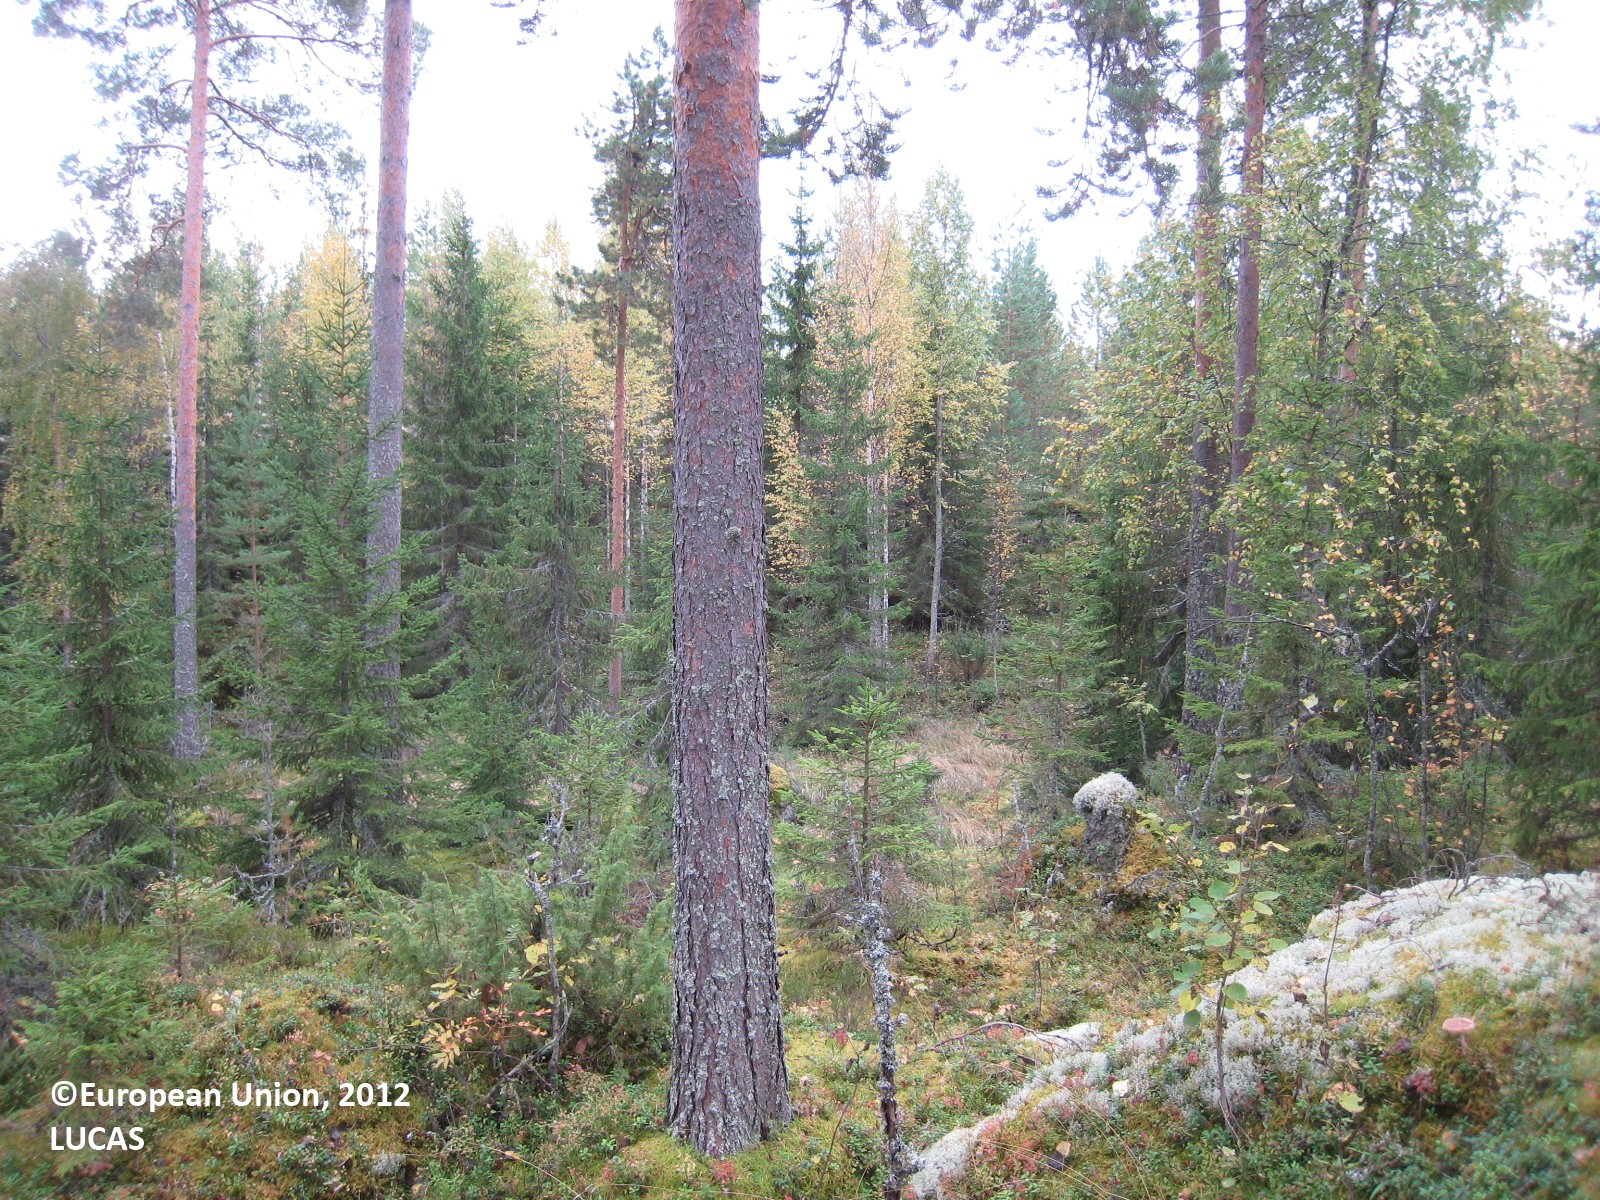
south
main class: Woodland
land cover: Other coniferous woodland
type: boreal forest
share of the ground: 50 - 75 %
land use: Forestry
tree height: > 5 m
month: September
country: FI
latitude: 62.5363
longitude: 26.5625
